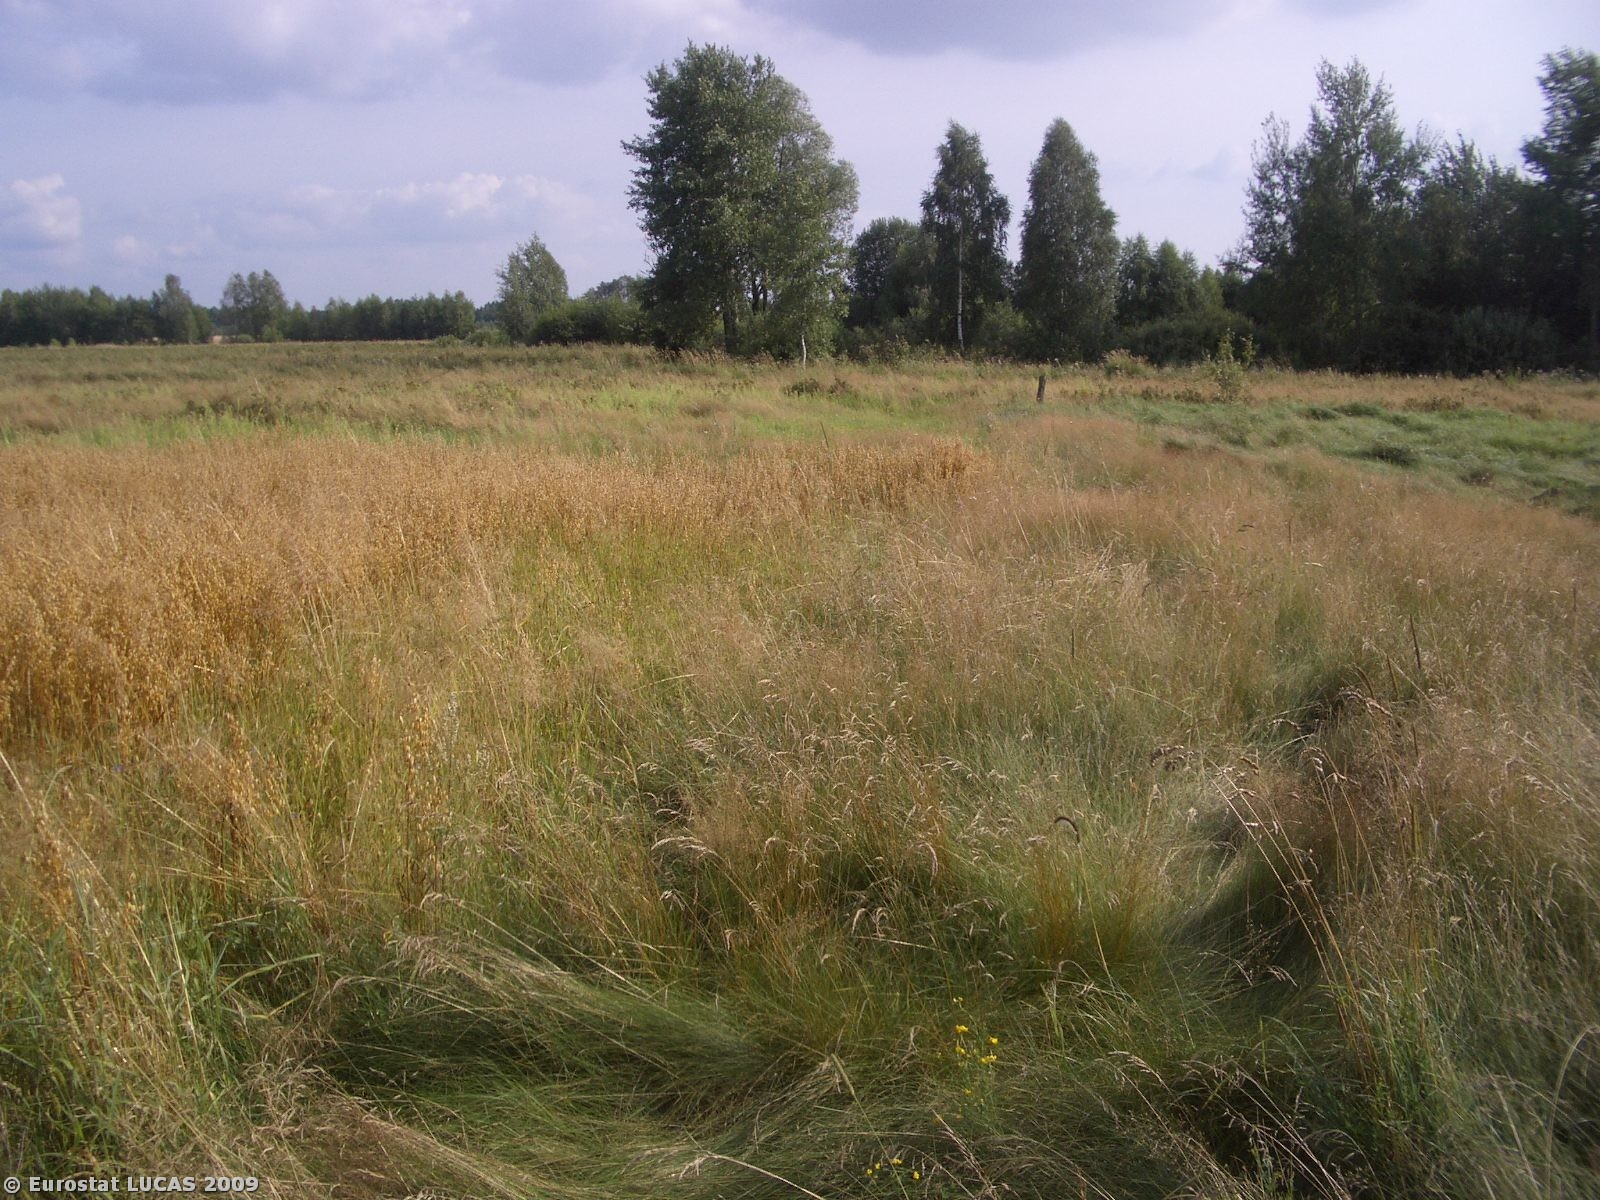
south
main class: Grassland
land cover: Grassland with sparse tree/shrub cover
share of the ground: > 75 %
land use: Unused
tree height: > 5 m
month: August
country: PL
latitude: 51.6412
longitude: 23.1555
